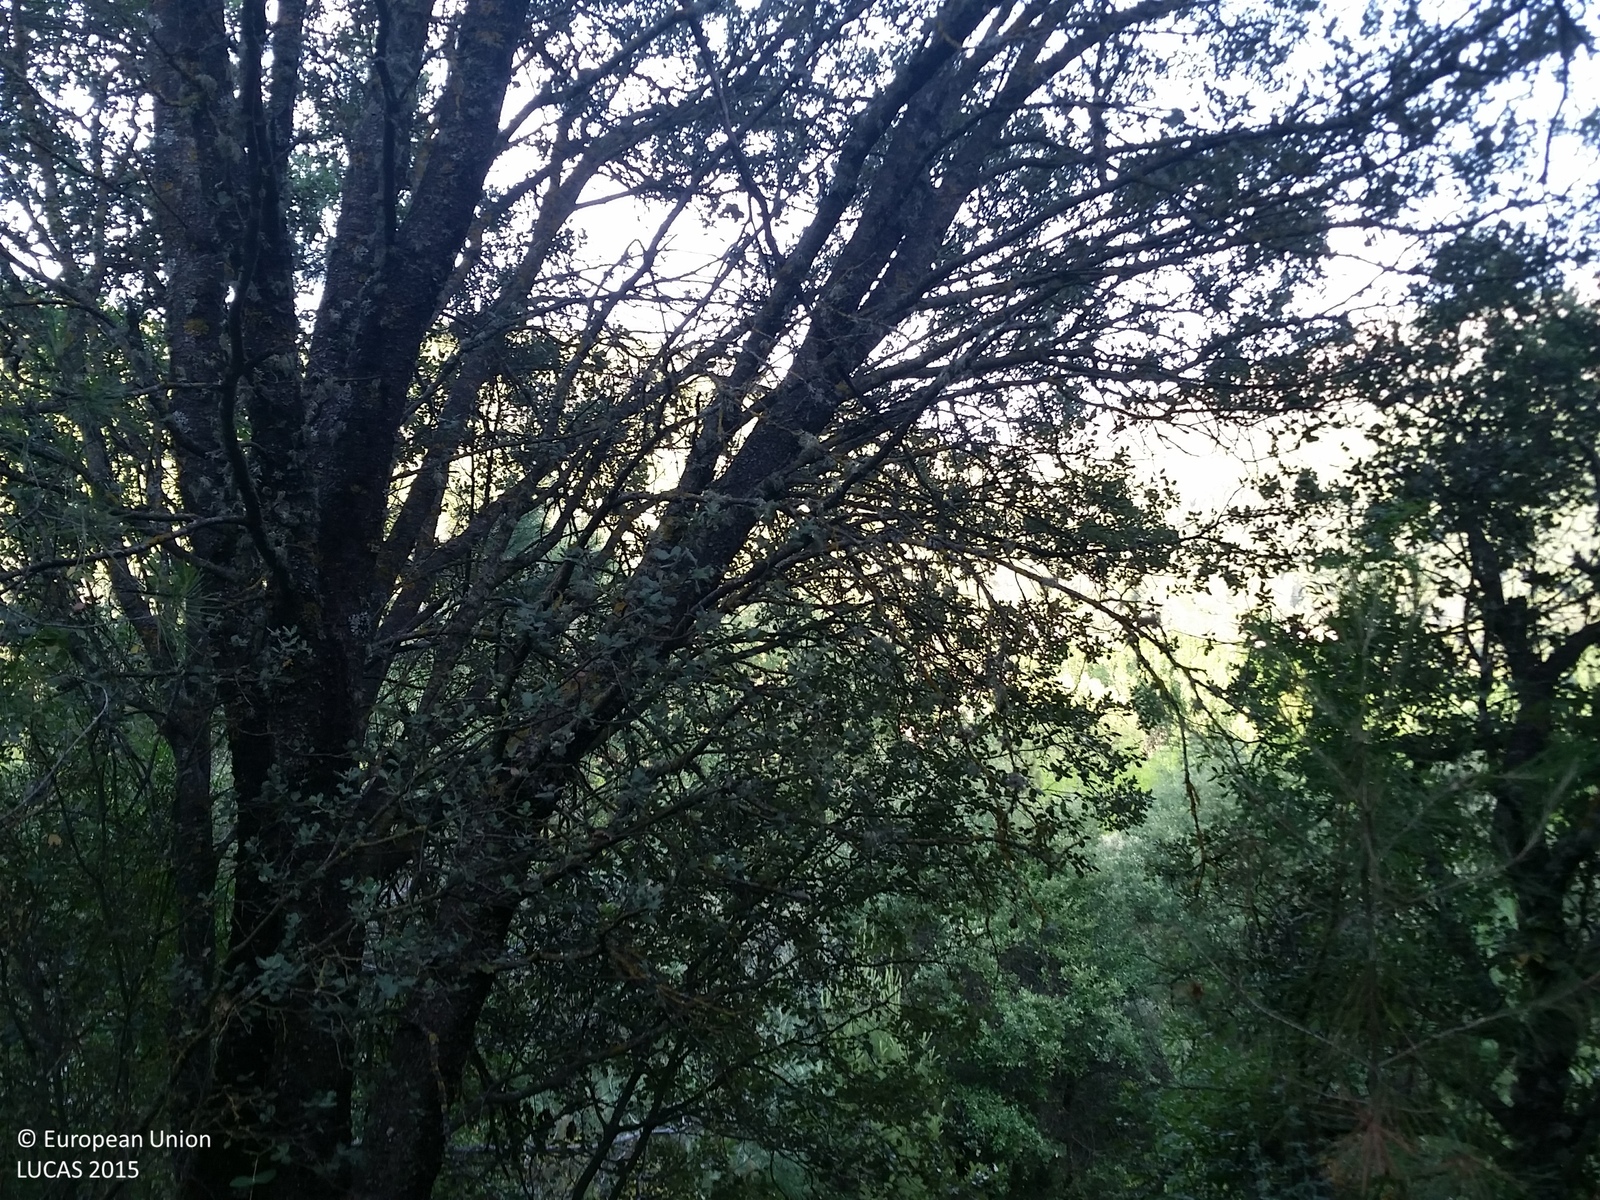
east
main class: Woodland
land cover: Other mixed woodland
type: coniferous forest of the mediterranean region
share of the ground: > 75 %
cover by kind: coniferous forest trees 35 %, broadleaved forest trees 35 %, shrubs 25 %, herbaceous plants 5 %
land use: Semi-natural and natural areas not in use
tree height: > 5 m
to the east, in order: Other mixed woodland; Olive groves; Grass margins; Olive groves; Grassland without tree/shrub cover; Pine dominated coniferous woodland; Tracks; Single bushes/trees; Broadleaved woodland; Single bushes/trees; Shruby margins; Inland fresh running water; Shruby margins; Grassland with sparse tree/shrub cover; Tracks; Single bushes/trees; Pine dominated coniferous woodland
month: July
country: ES
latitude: 38.3745
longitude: -2.4392
